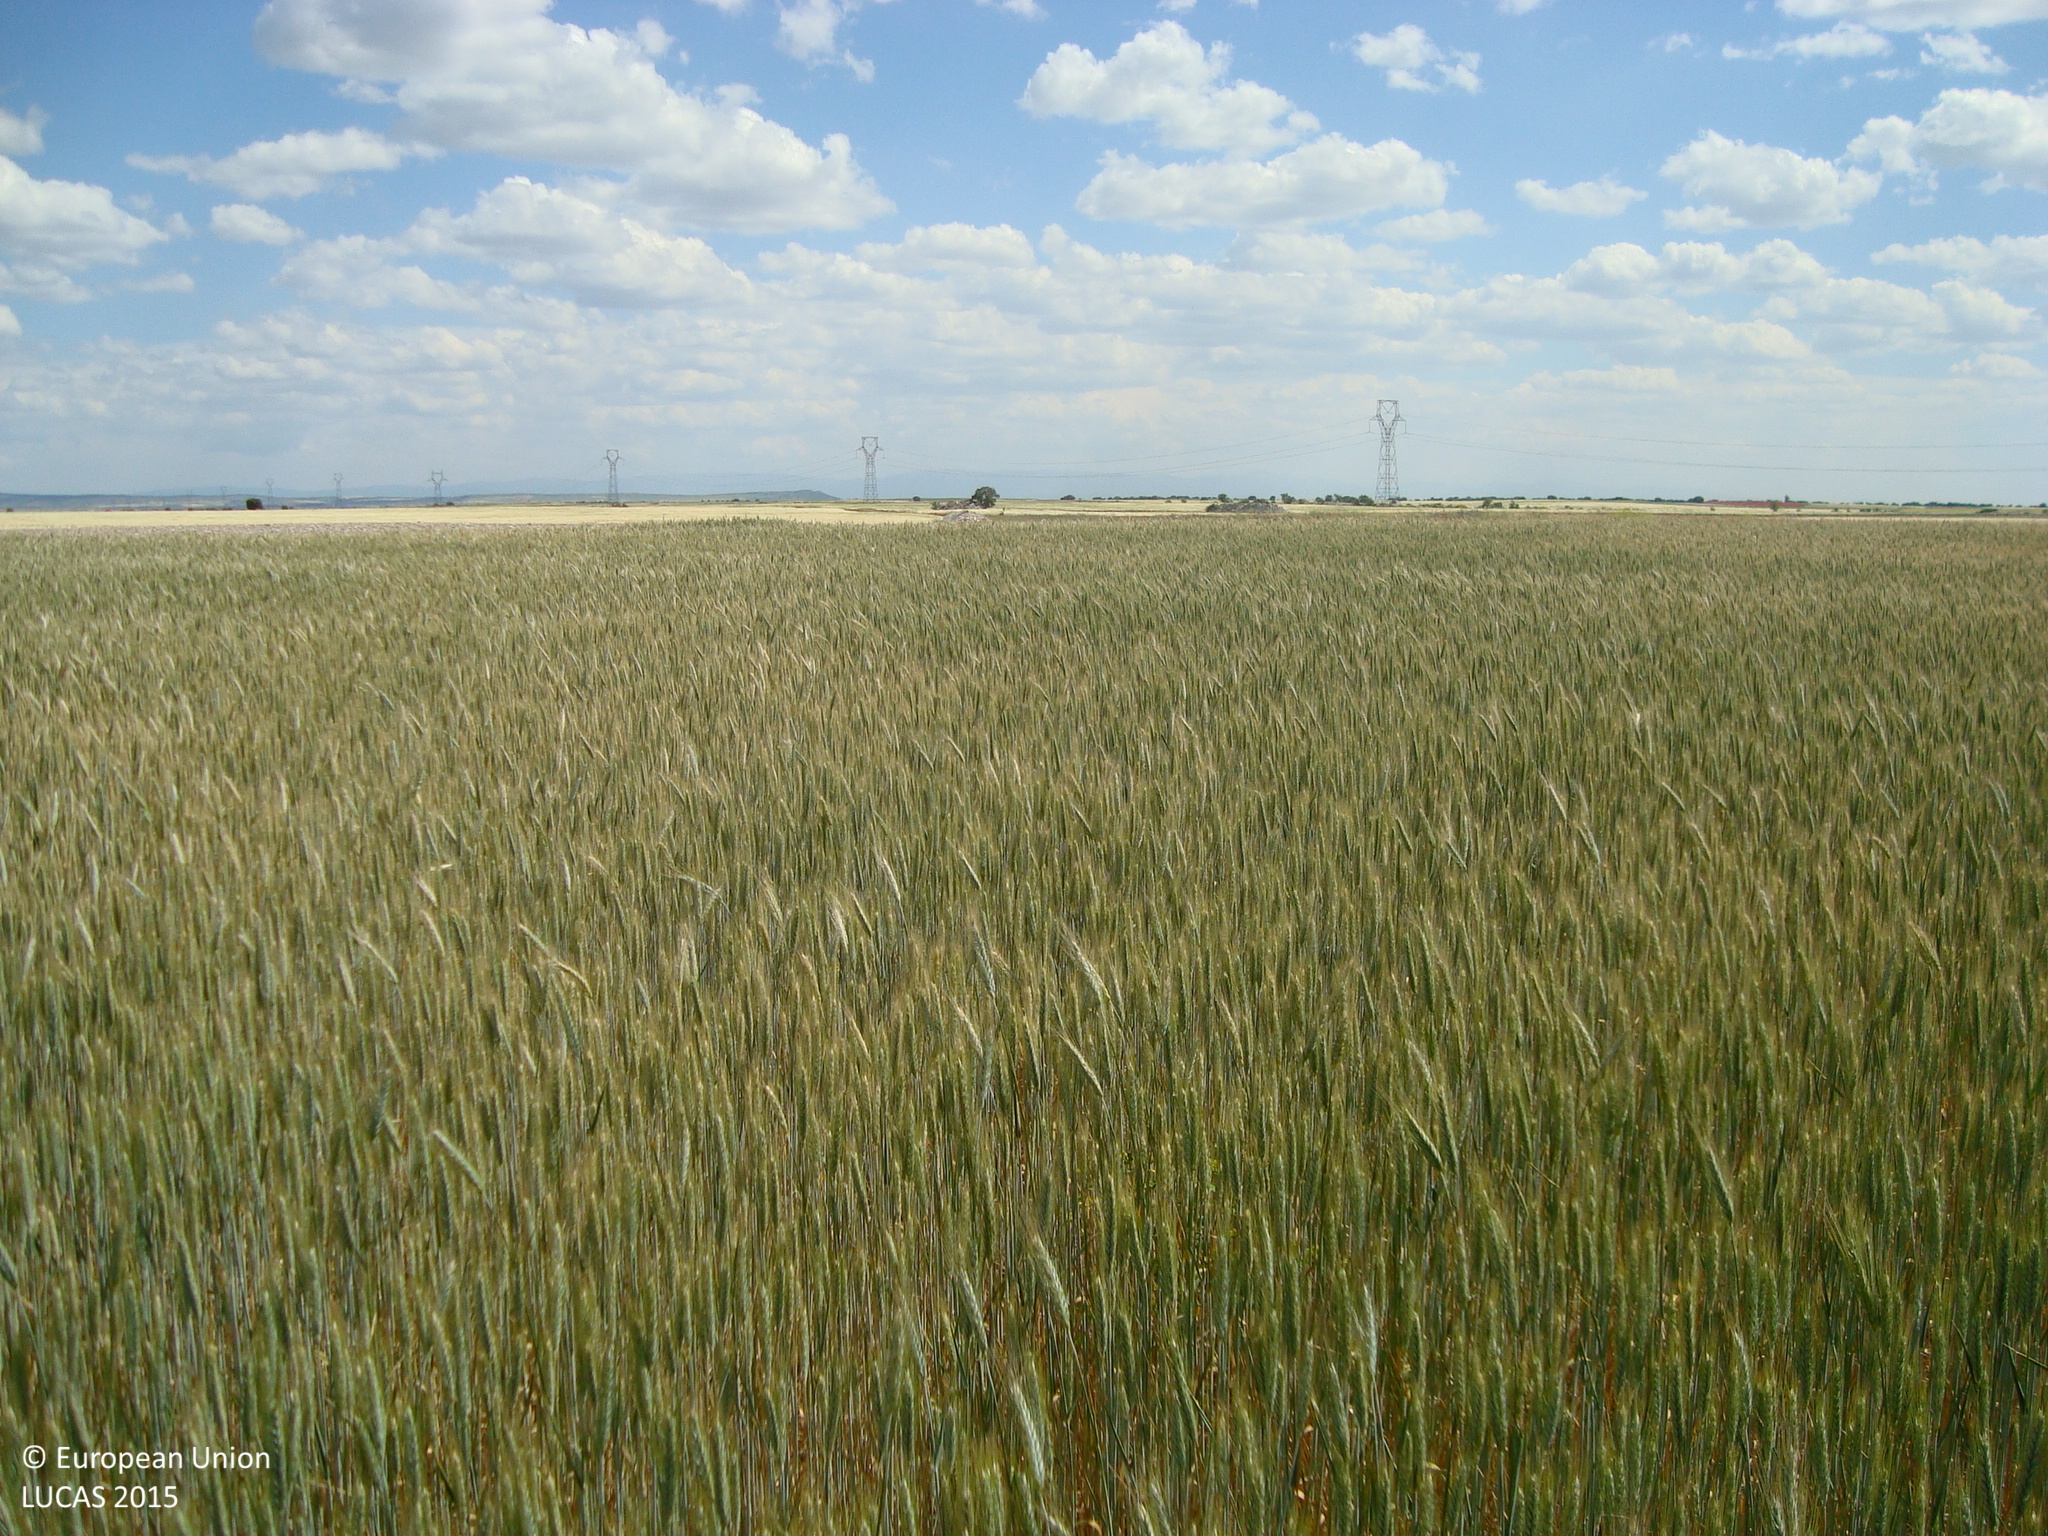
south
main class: Cropland
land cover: Rye
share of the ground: > 75 %
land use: Agriculture (excluding fallow land and kitchen gardens)
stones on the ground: < 10 %
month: May
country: ES
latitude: 41.5483
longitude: -3.9984
